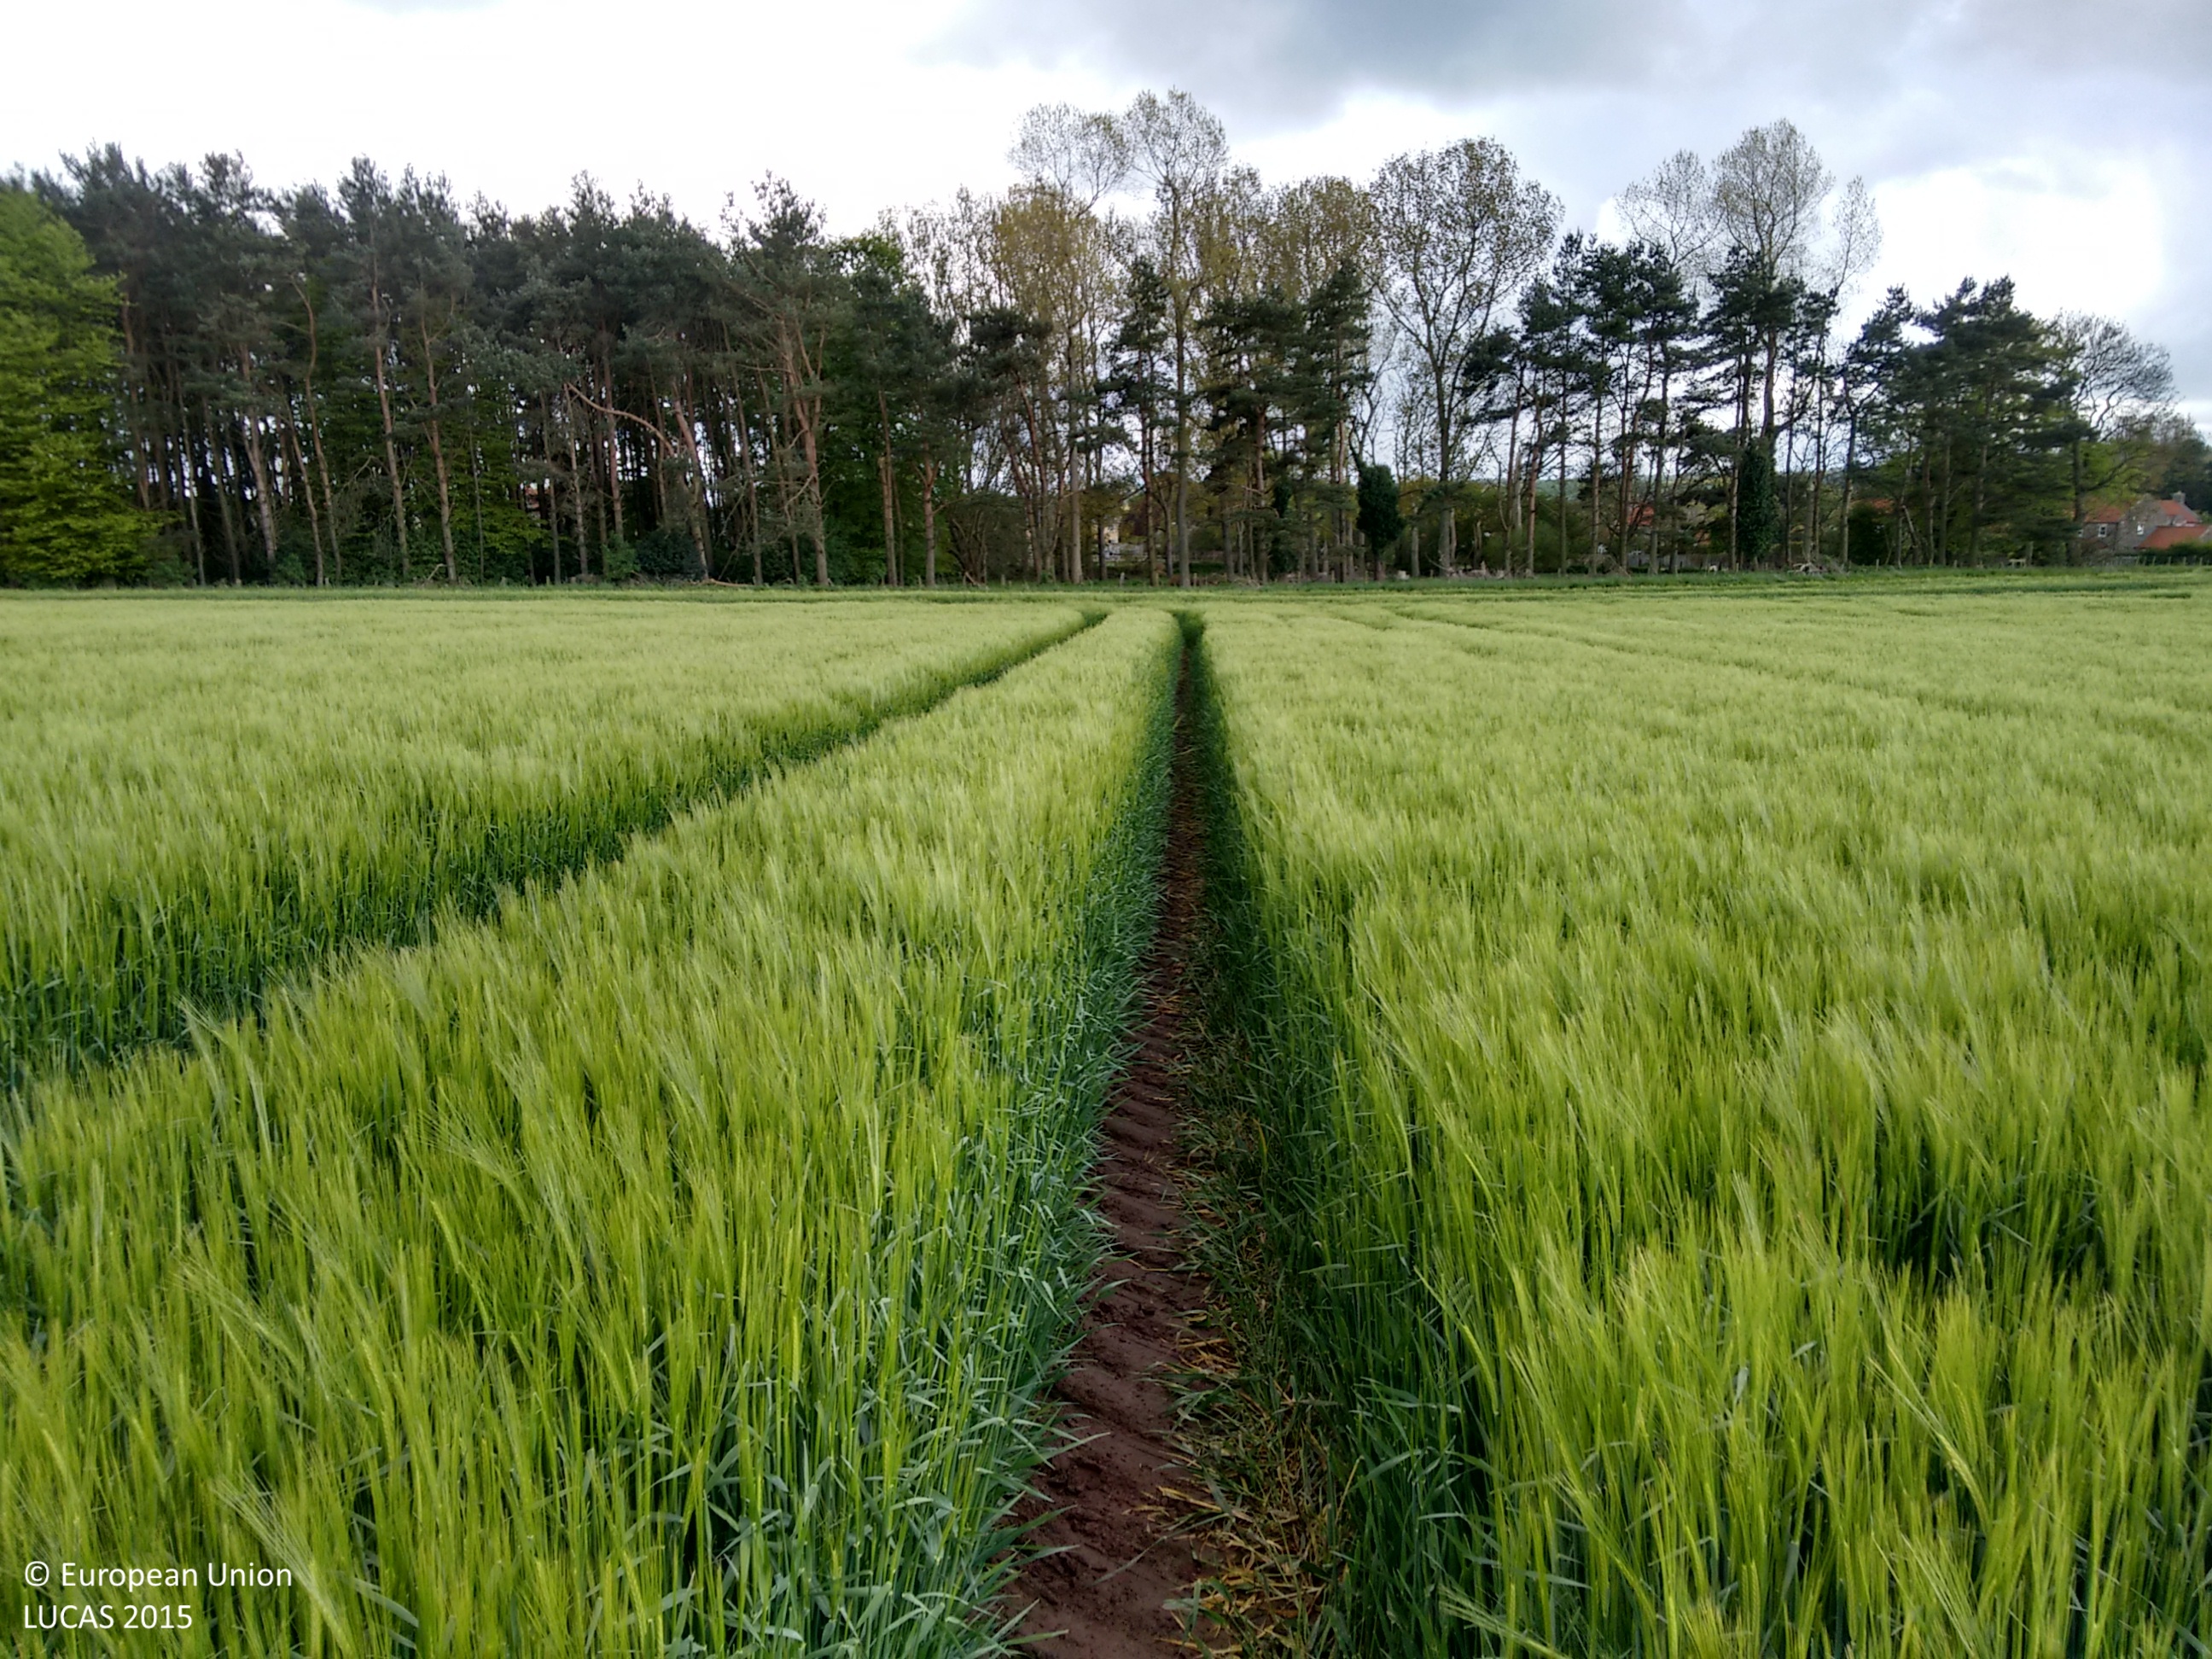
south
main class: Cropland
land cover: Barley
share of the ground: > 75 %
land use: Agriculture (excluding fallow land and kitchen gardens)
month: May
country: GB
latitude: 55.4029
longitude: -1.6232
